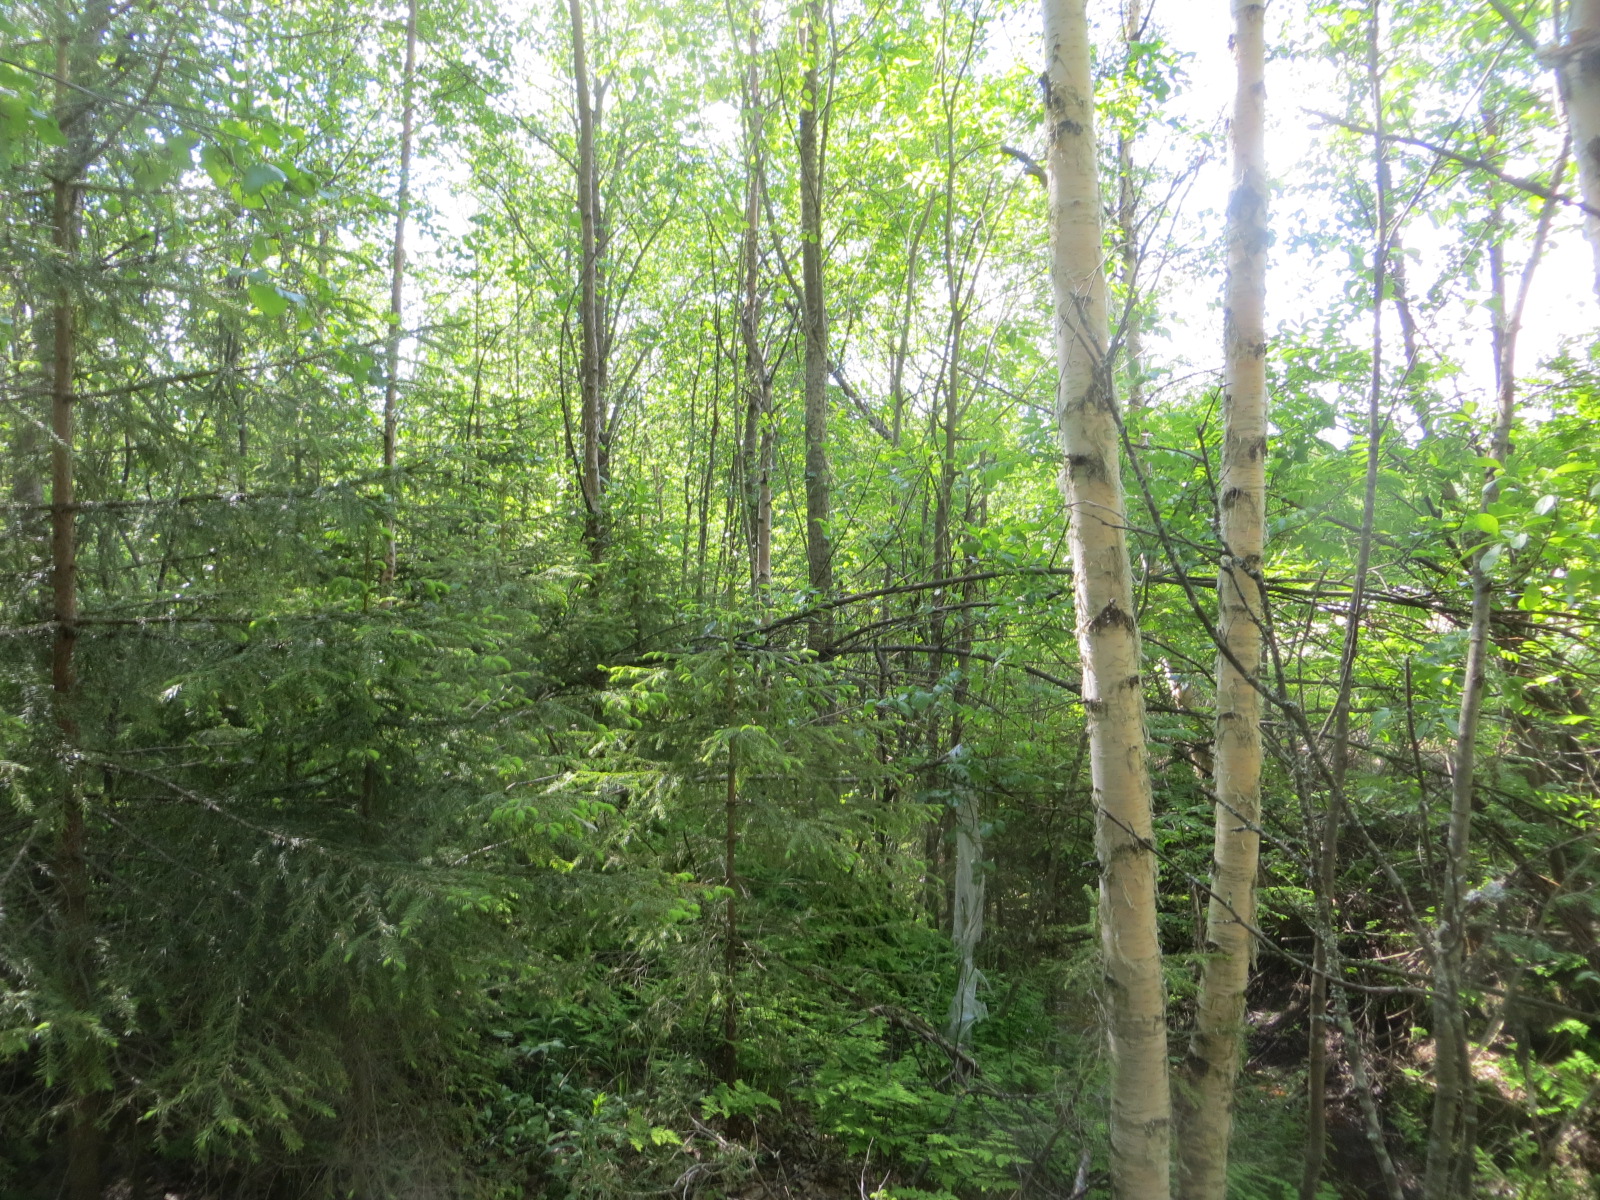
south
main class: Woodland
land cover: Other mixed woodland
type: boreal forest
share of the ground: > 75 %
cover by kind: broadleaved forest trees 45 %, coniferous forest trees 40 %, herbaceous plants 15 %
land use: Forestry
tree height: > 5 m
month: June
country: FI
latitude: 66.5043
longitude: 25.6441
